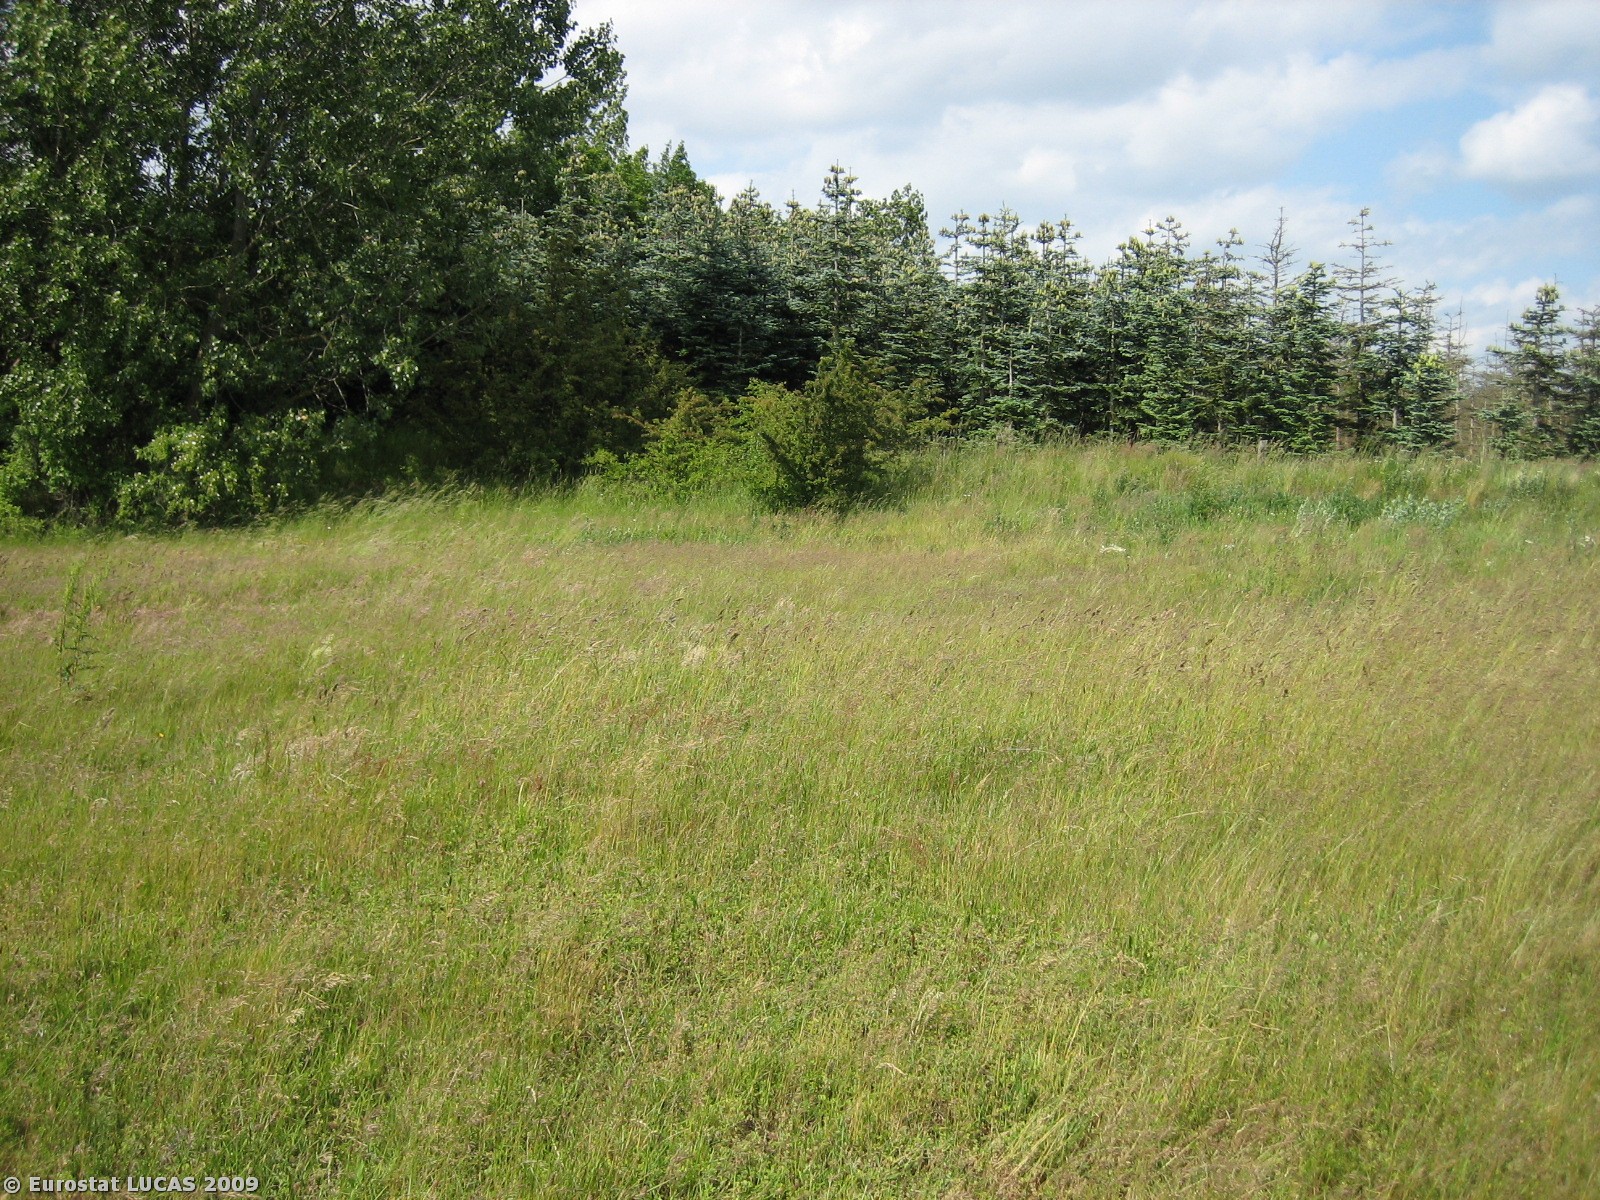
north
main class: Grassland
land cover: Grassland without tree/shrub cover
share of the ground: > 75 %
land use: Amenities, museums, leisure
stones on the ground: 25 - 50 %
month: June
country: DK
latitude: 55.8282
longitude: 10.0160
